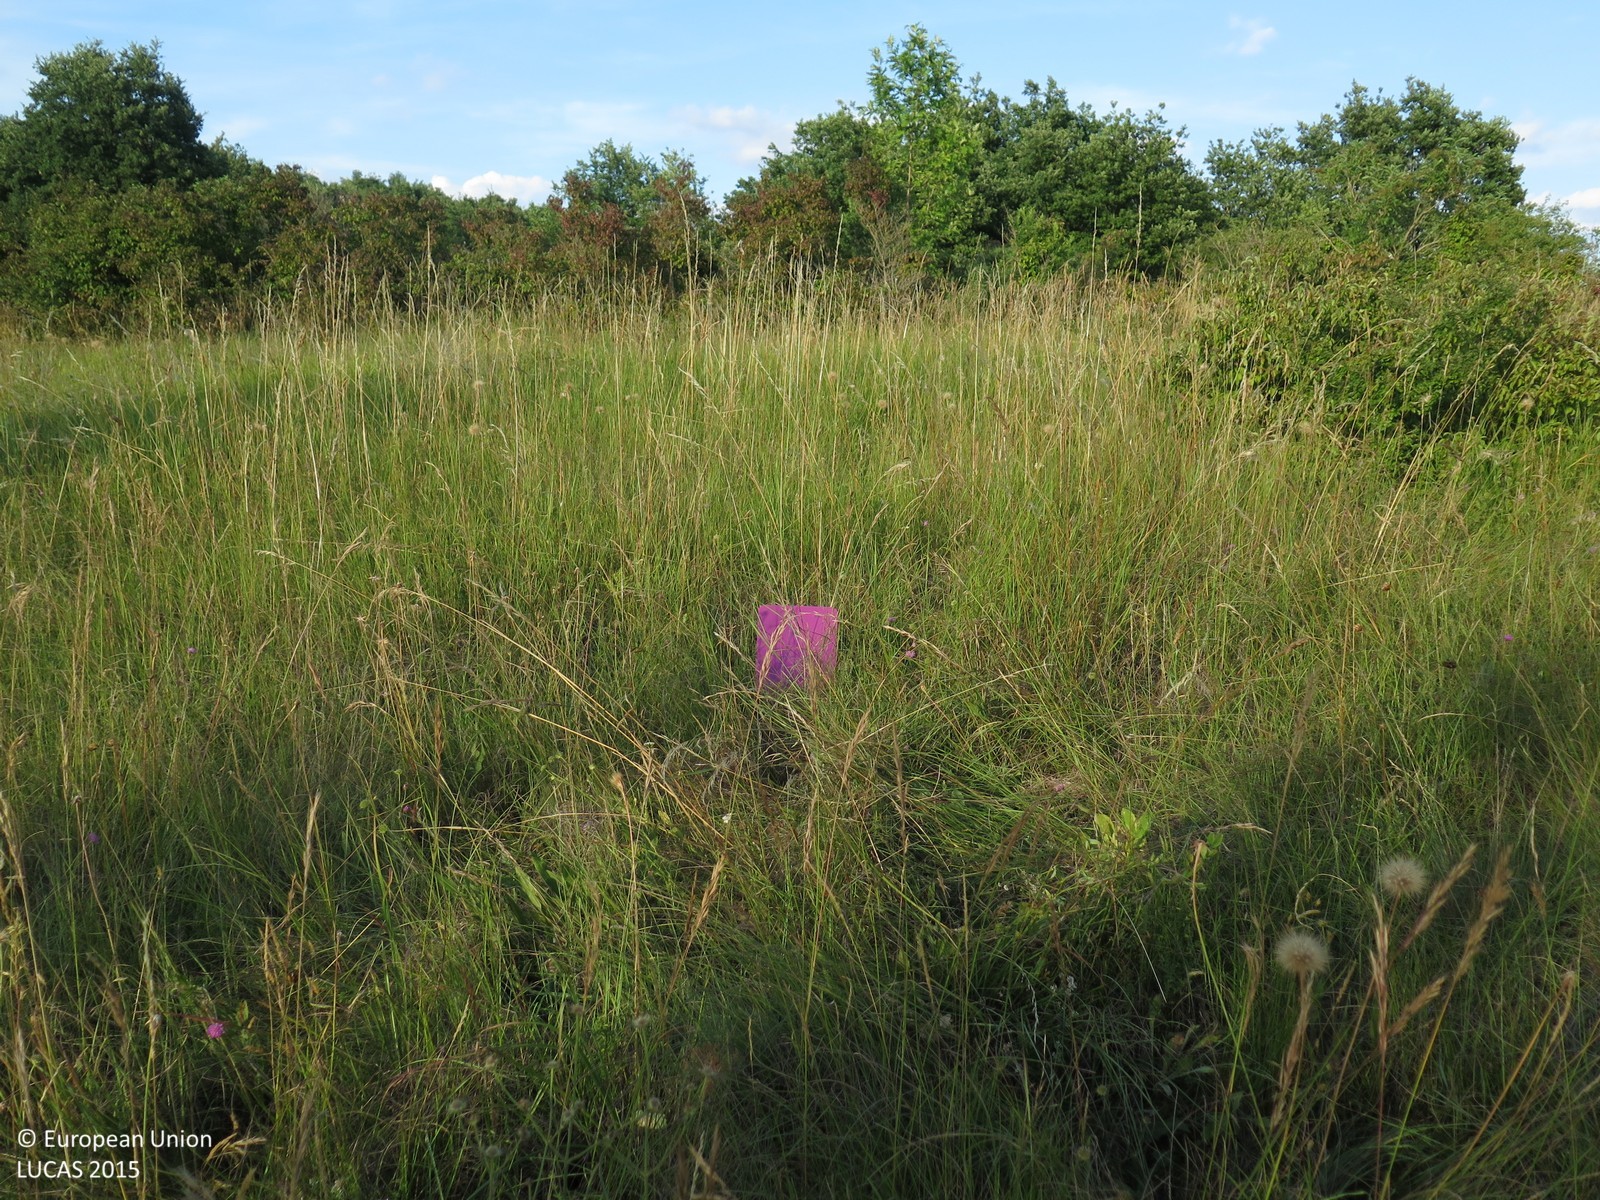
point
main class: Grassland
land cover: Grassland with sparse tree/shrub cover
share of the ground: > 75 %
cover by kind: herbaceous plants 90 %, broadleaved forest trees 5 %, shrubs 5 %
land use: Abandoned areas
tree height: > 5 m
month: June
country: HR
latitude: 45.1200
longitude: 14.0498
